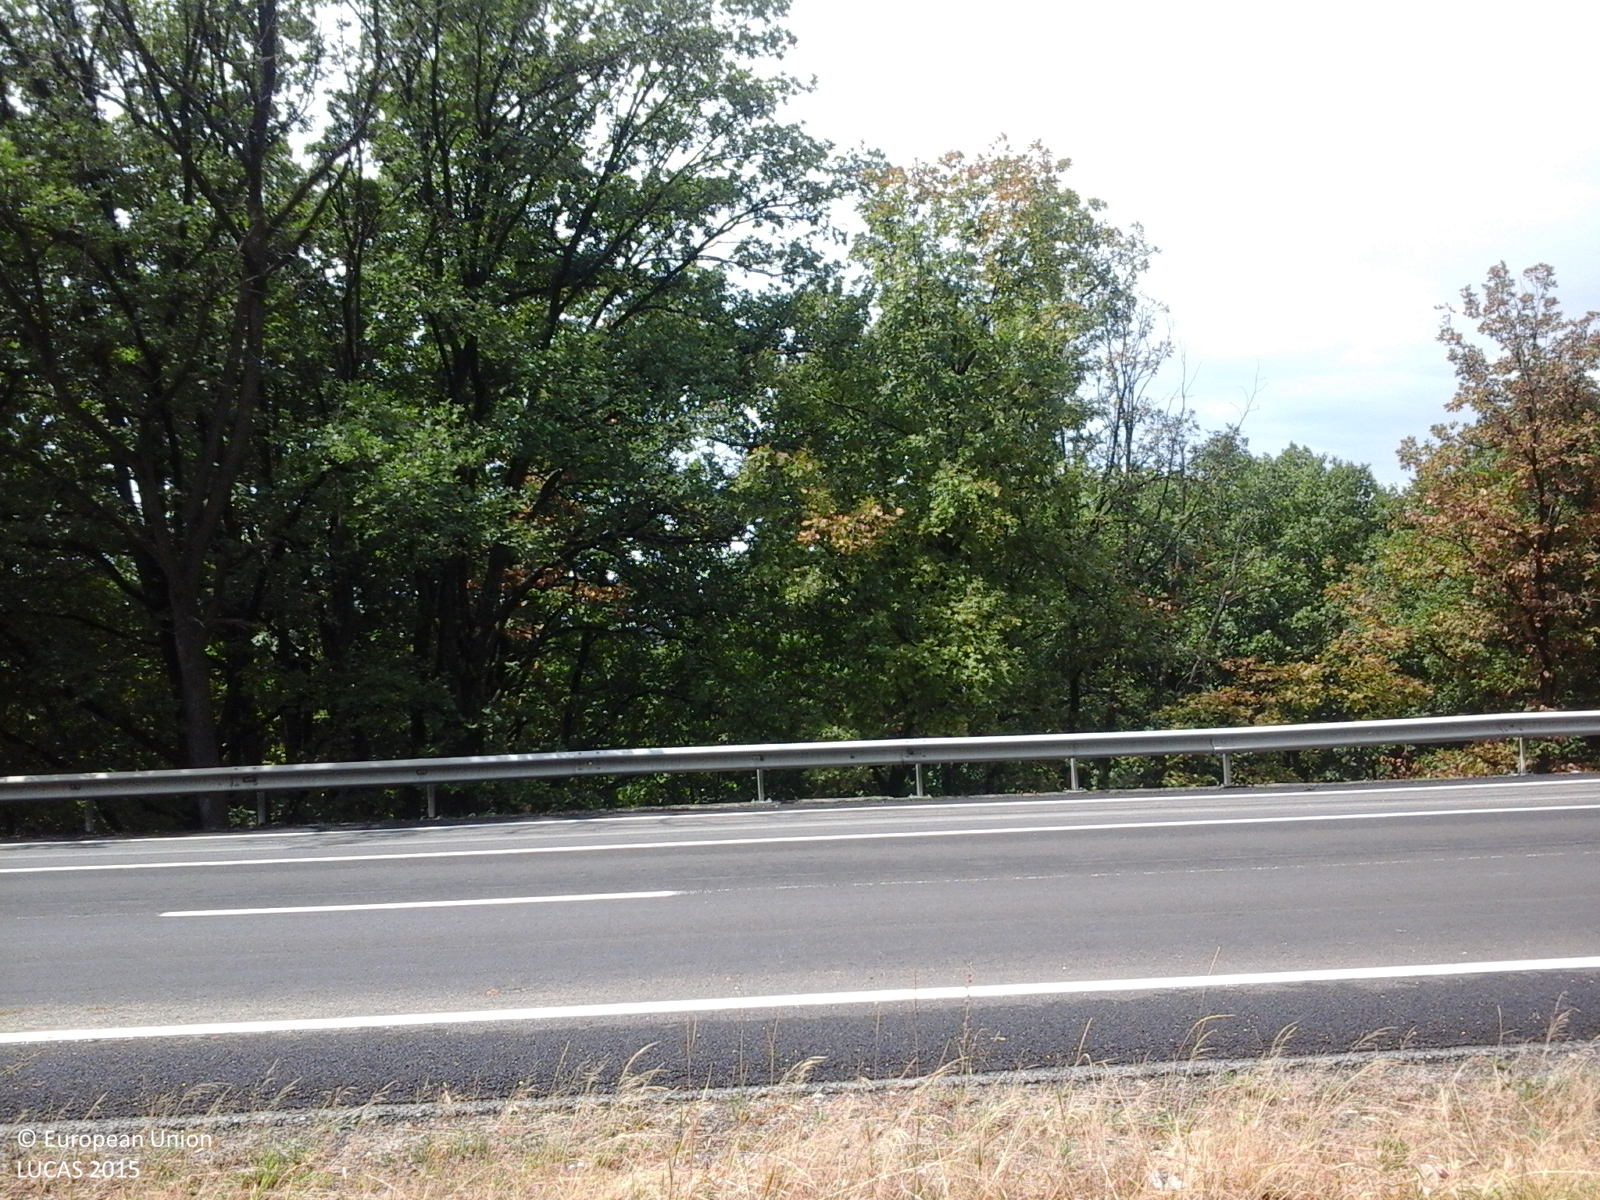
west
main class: Grassland
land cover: Grassland without tree/shrub cover
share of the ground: > 75 %
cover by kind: herbaceous plants 100 %
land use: Semi-natural and natural areas not in use
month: August
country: RO
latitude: 44.6142
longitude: 22.7834
